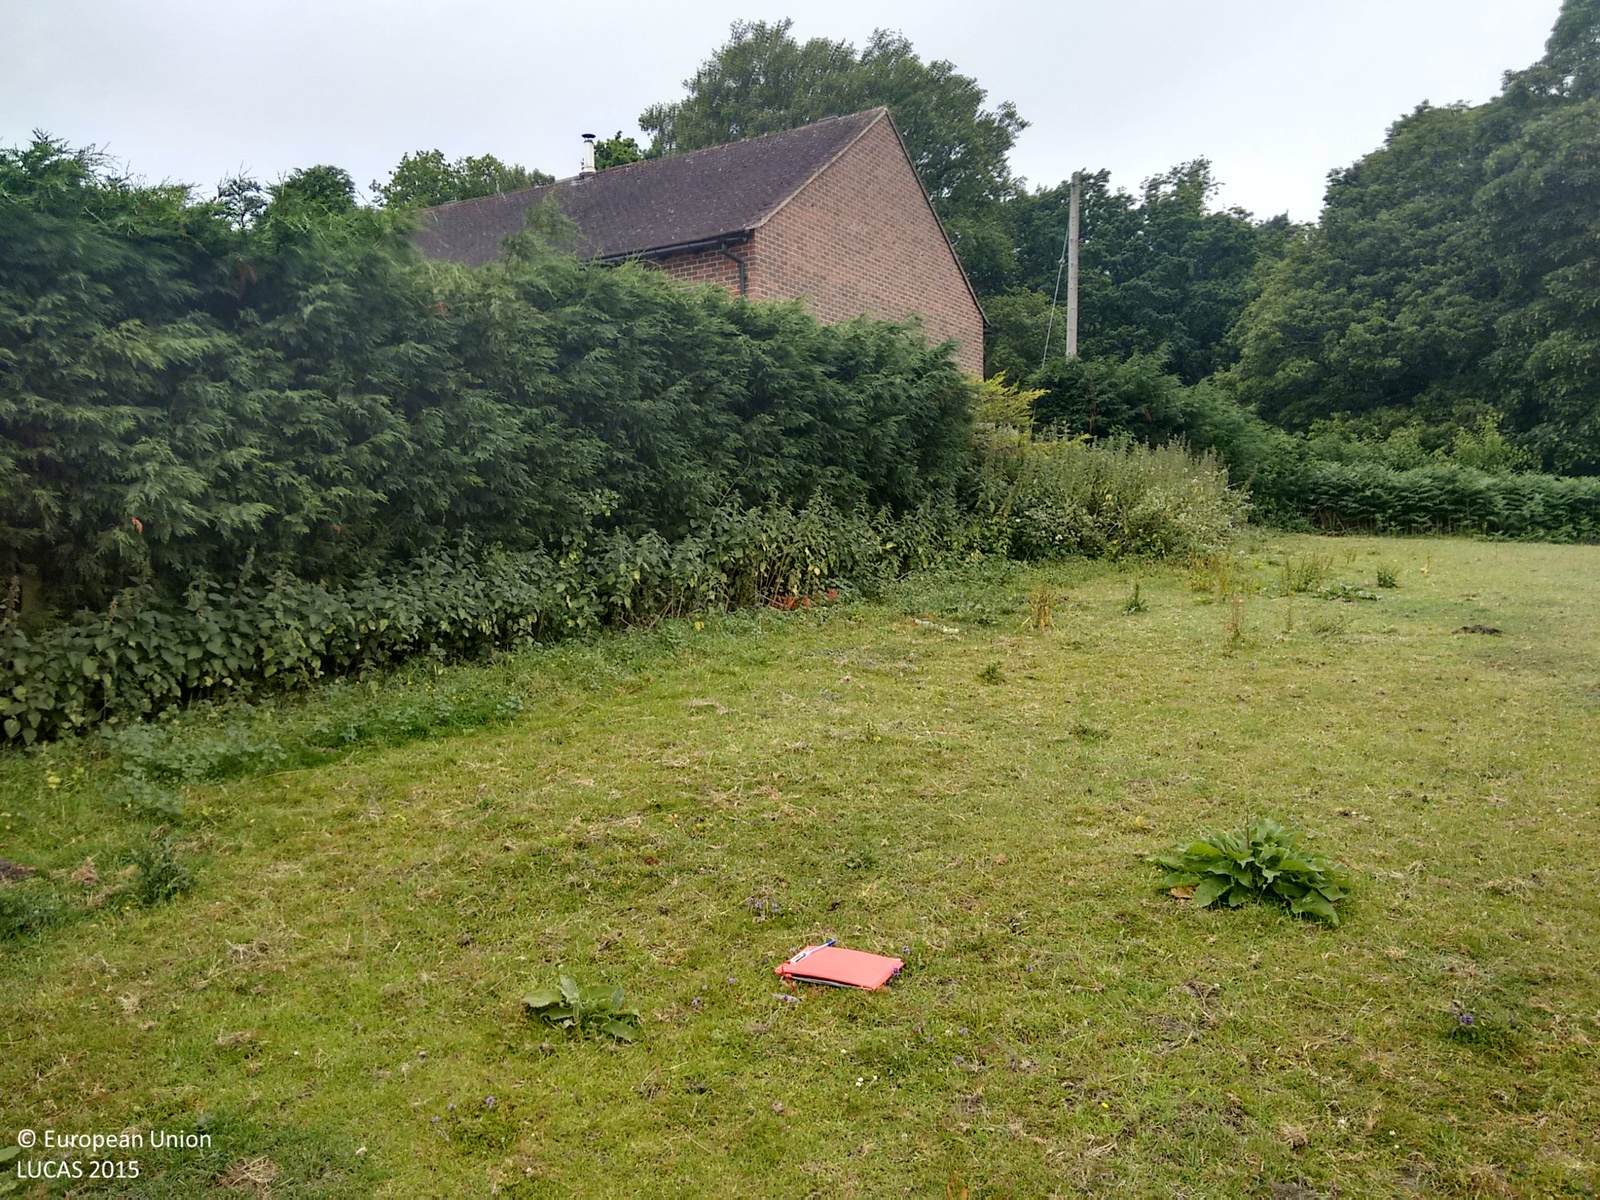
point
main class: Grassland
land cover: Grassland without tree/shrub cover
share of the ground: > 75 %
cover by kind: herbaceous plants 100 %
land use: Agriculture (excluding fallow land and kitchen gardens)
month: July
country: GB
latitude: 50.9189
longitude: -0.4359
